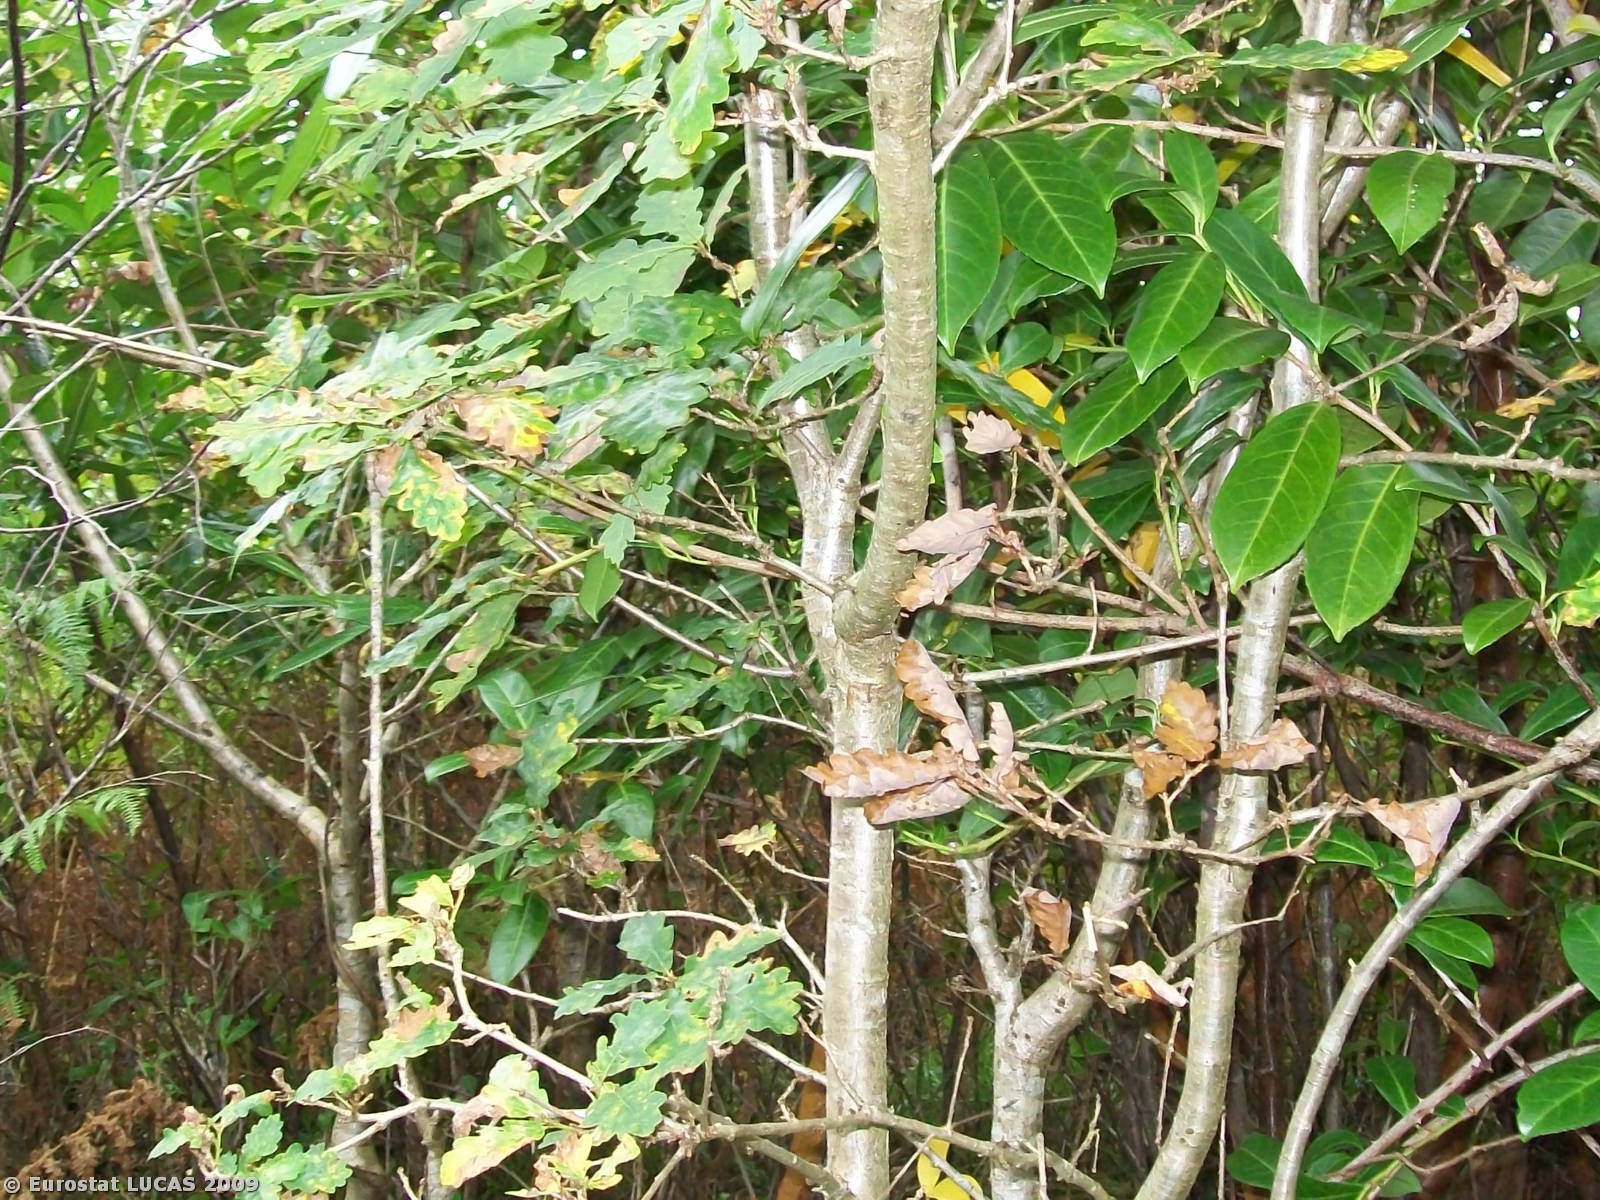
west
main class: Woodland
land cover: Broadleaved woodland
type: acidophilous oak and oak-birch forest
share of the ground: > 75 %
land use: Forestry
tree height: > 5 m
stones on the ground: < 10 %
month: September
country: IE
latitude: 53.0664
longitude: -8.3811
